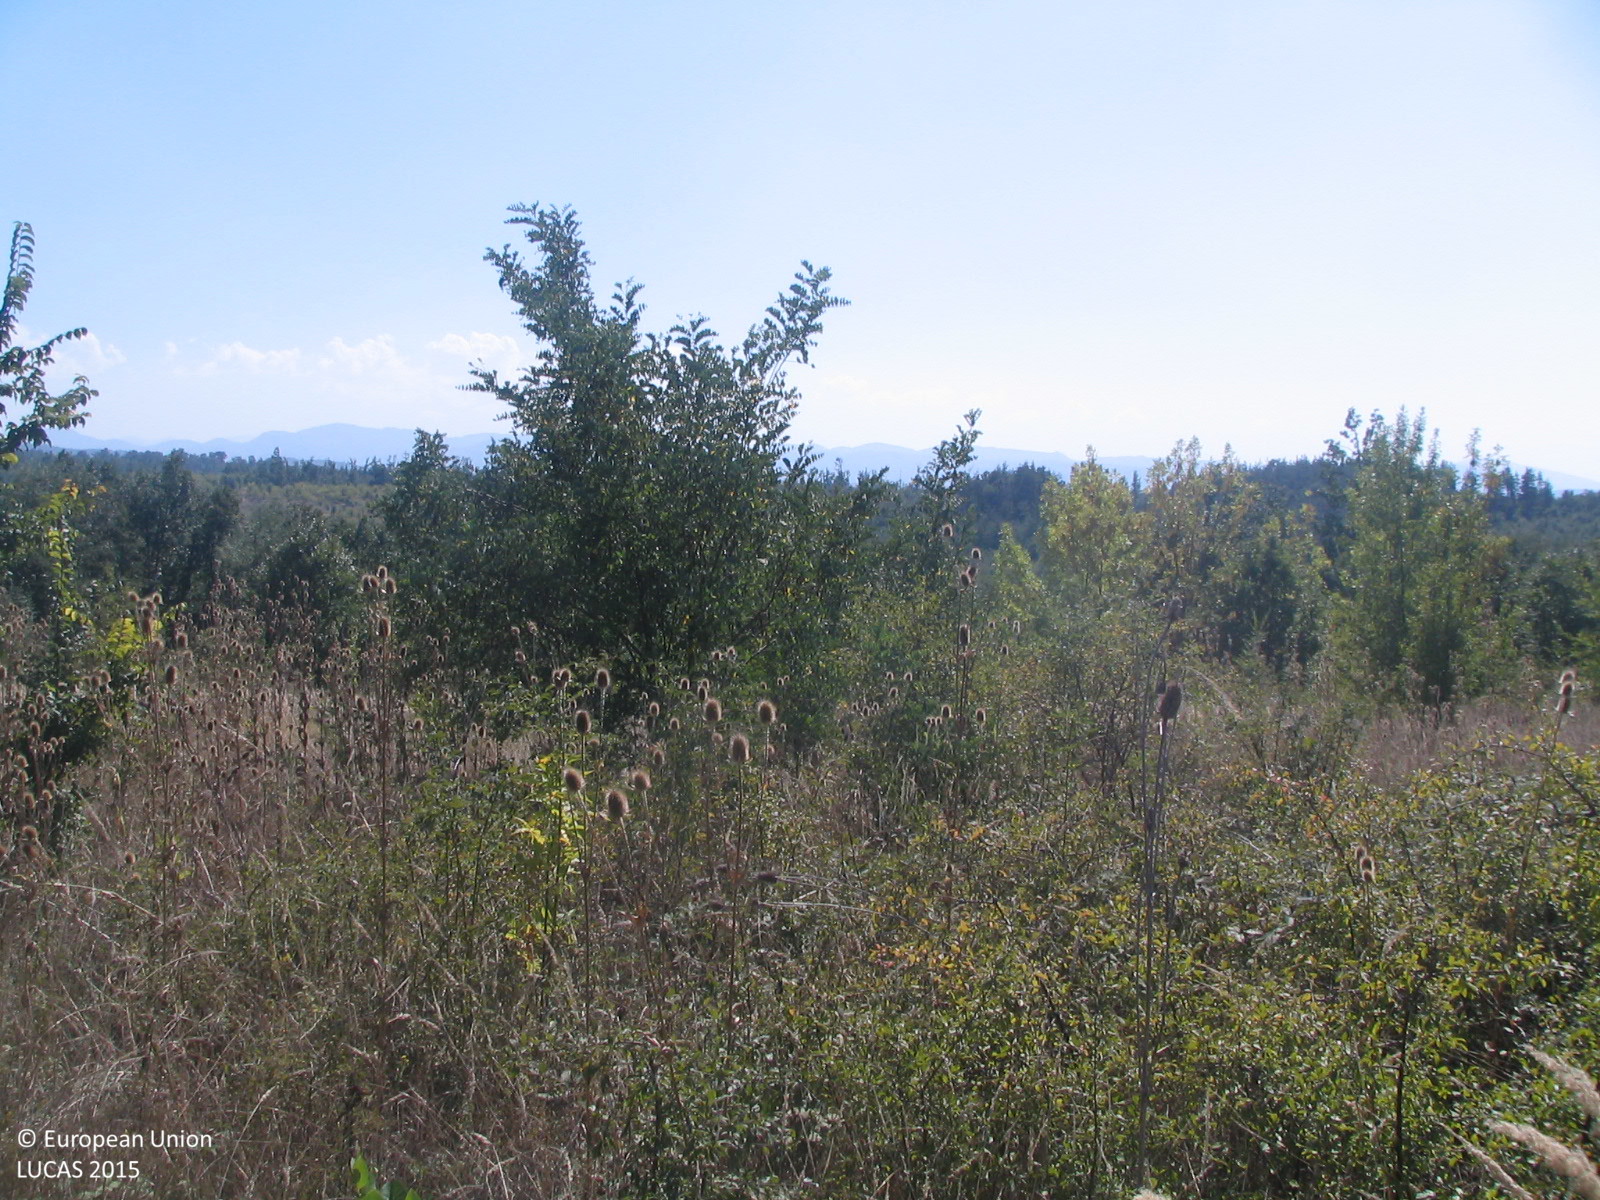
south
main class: Woodland
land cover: Broadleaved woodland
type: mesophytic deciduous forest
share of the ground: 25 - 50 %
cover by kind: herbaceous plants 40 %, broadleaved forest trees 30 %, shrubs 30 %
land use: Semi-natural and natural areas not in use
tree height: > 5 m
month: September
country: BG
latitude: 43.1308
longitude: 24.3267
